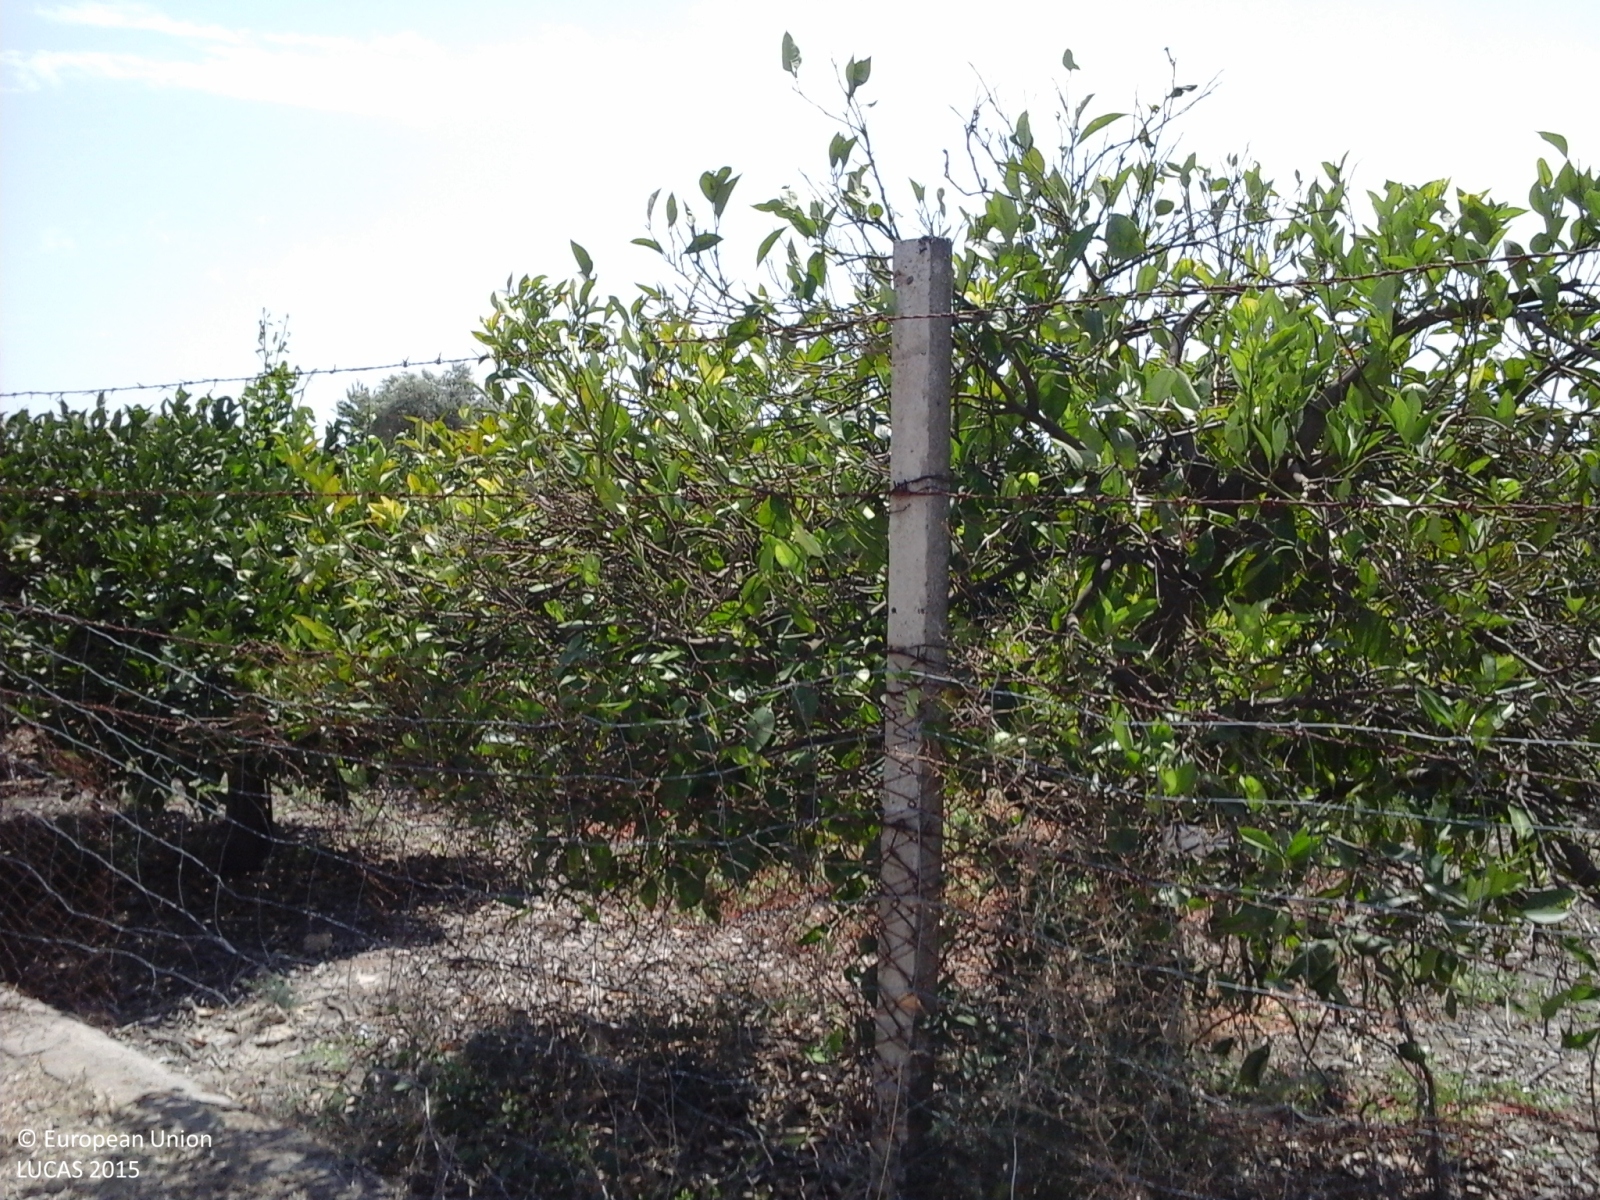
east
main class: Cropland
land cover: Oranges
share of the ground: > 75 %
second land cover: Spontaneously vegetated surfaces
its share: > 75 %
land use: Agriculture (excluding fallow land and kitchen gardens)
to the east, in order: Oranges; Spontaneously vegetated surfaces; Fences; Mixed cereals for fodder; Grassland without tree/shrub cover; Dry stone walls; Tracks; Dry stone walls; Grassland without tree/shrub cover; Fences; Other bare soil; Fences; Grassland without tree/shrub cover
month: August
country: IT
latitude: 37.3146
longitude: 14.8497
